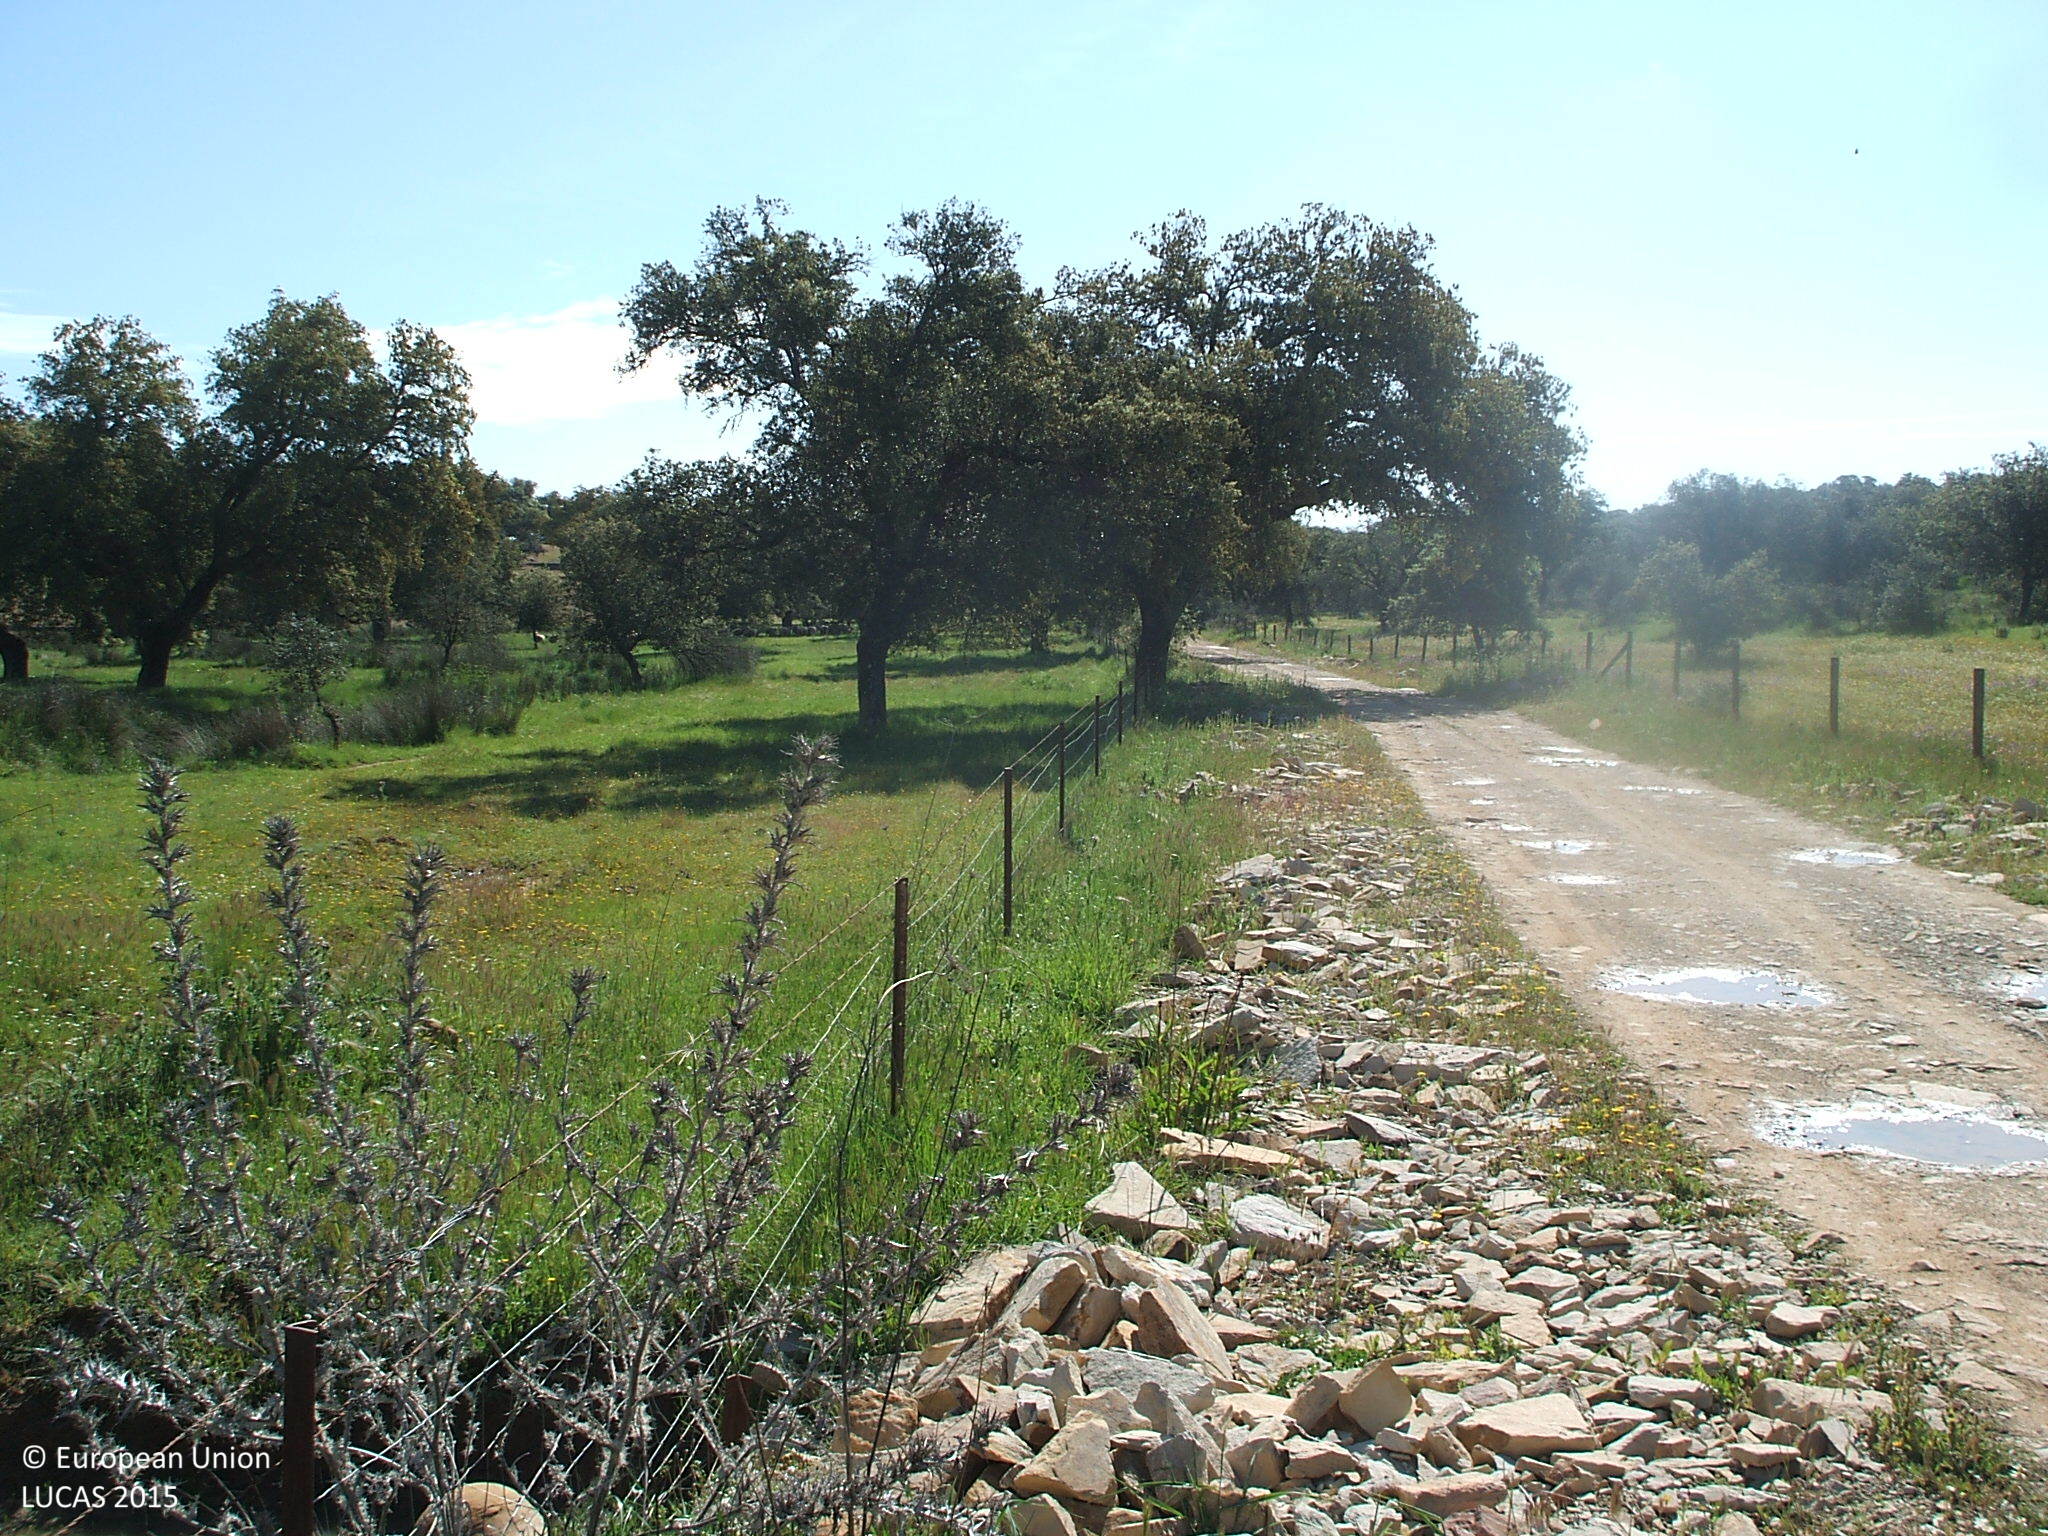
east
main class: Woodland
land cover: Broadleaved woodland
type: broadleaved evergreen forest
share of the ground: 25 - 50 %
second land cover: Grassland without tree/shrub cover
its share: > 75 %
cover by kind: herbaceous plants 75 %, broadleaved forest trees 25 %
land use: Forestry
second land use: Agriculture (excluding fallow land and kitchen gardens)
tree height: > 5 m
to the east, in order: Broadleaved woodland; Grassland without tree/shrub cover
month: April
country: ES
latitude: 38.0136
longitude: -5.6221
